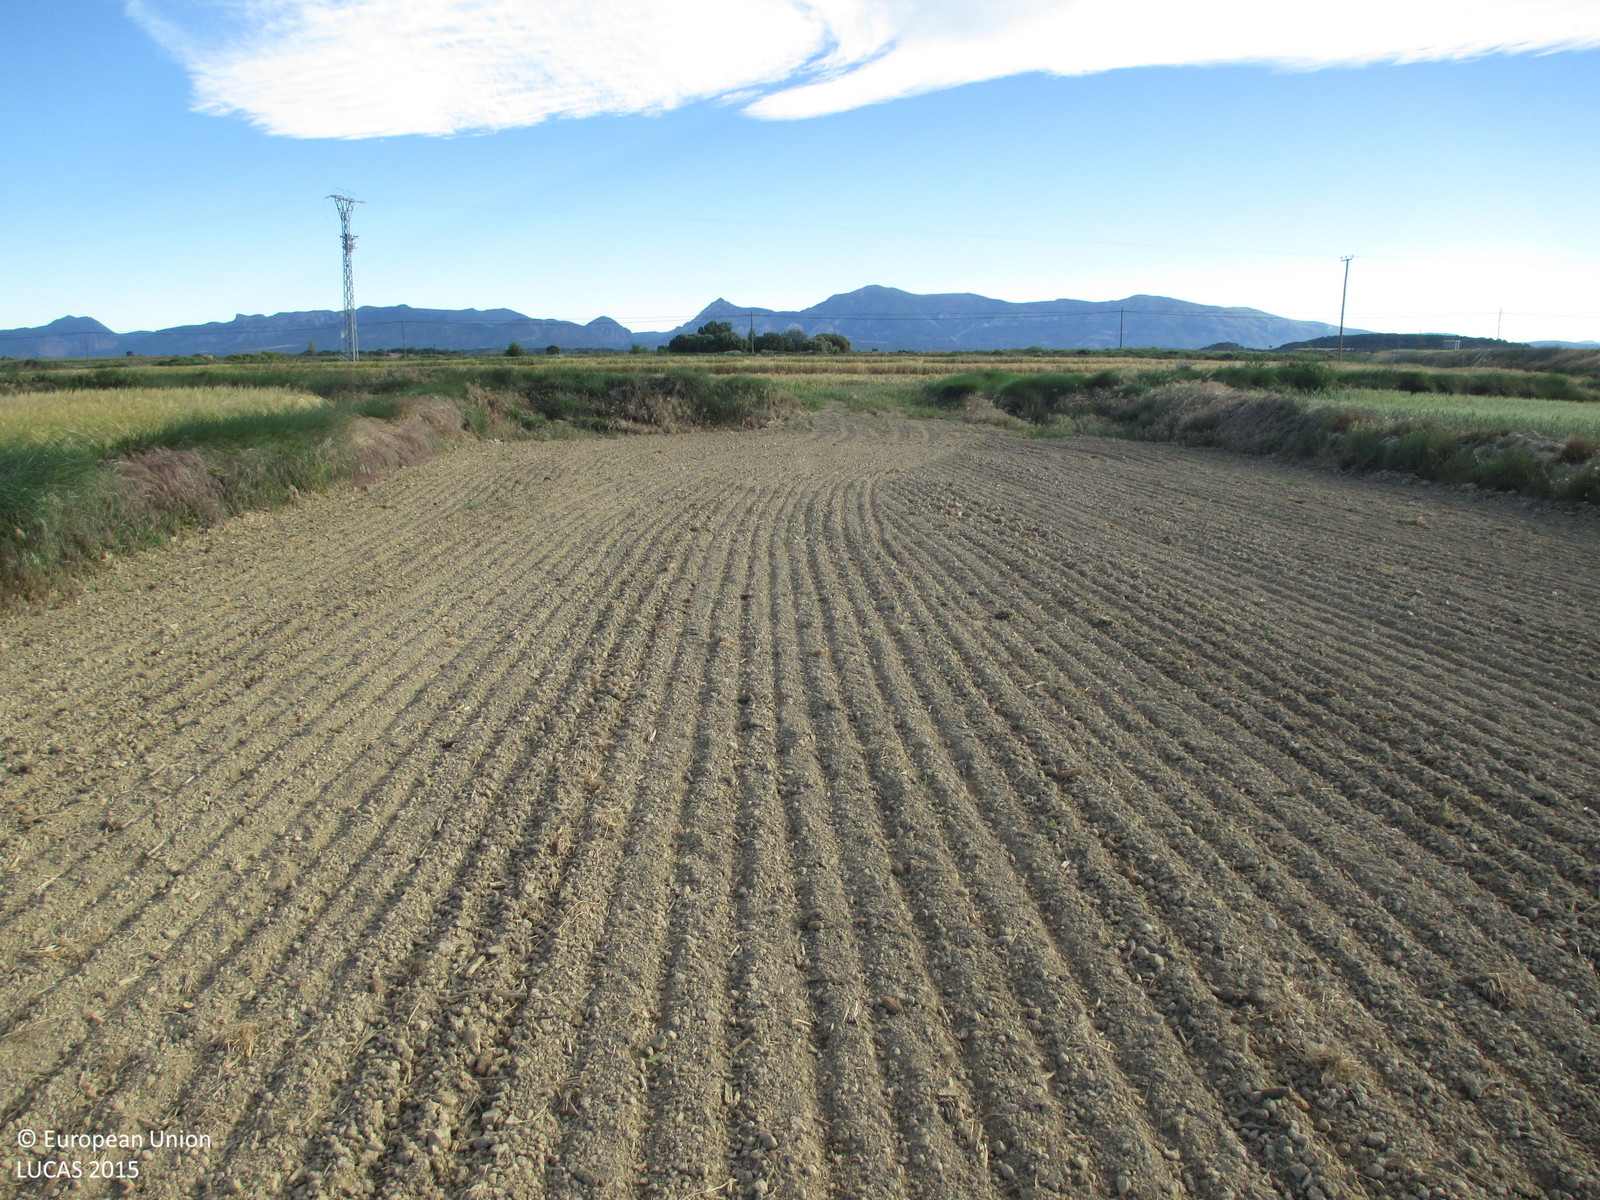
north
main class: Cropland
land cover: Maize
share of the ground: < 10 %
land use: Agriculture (excluding fallow land and kitchen gardens)
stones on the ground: < 10 %
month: May
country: ES
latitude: 42.0747
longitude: -0.2830
